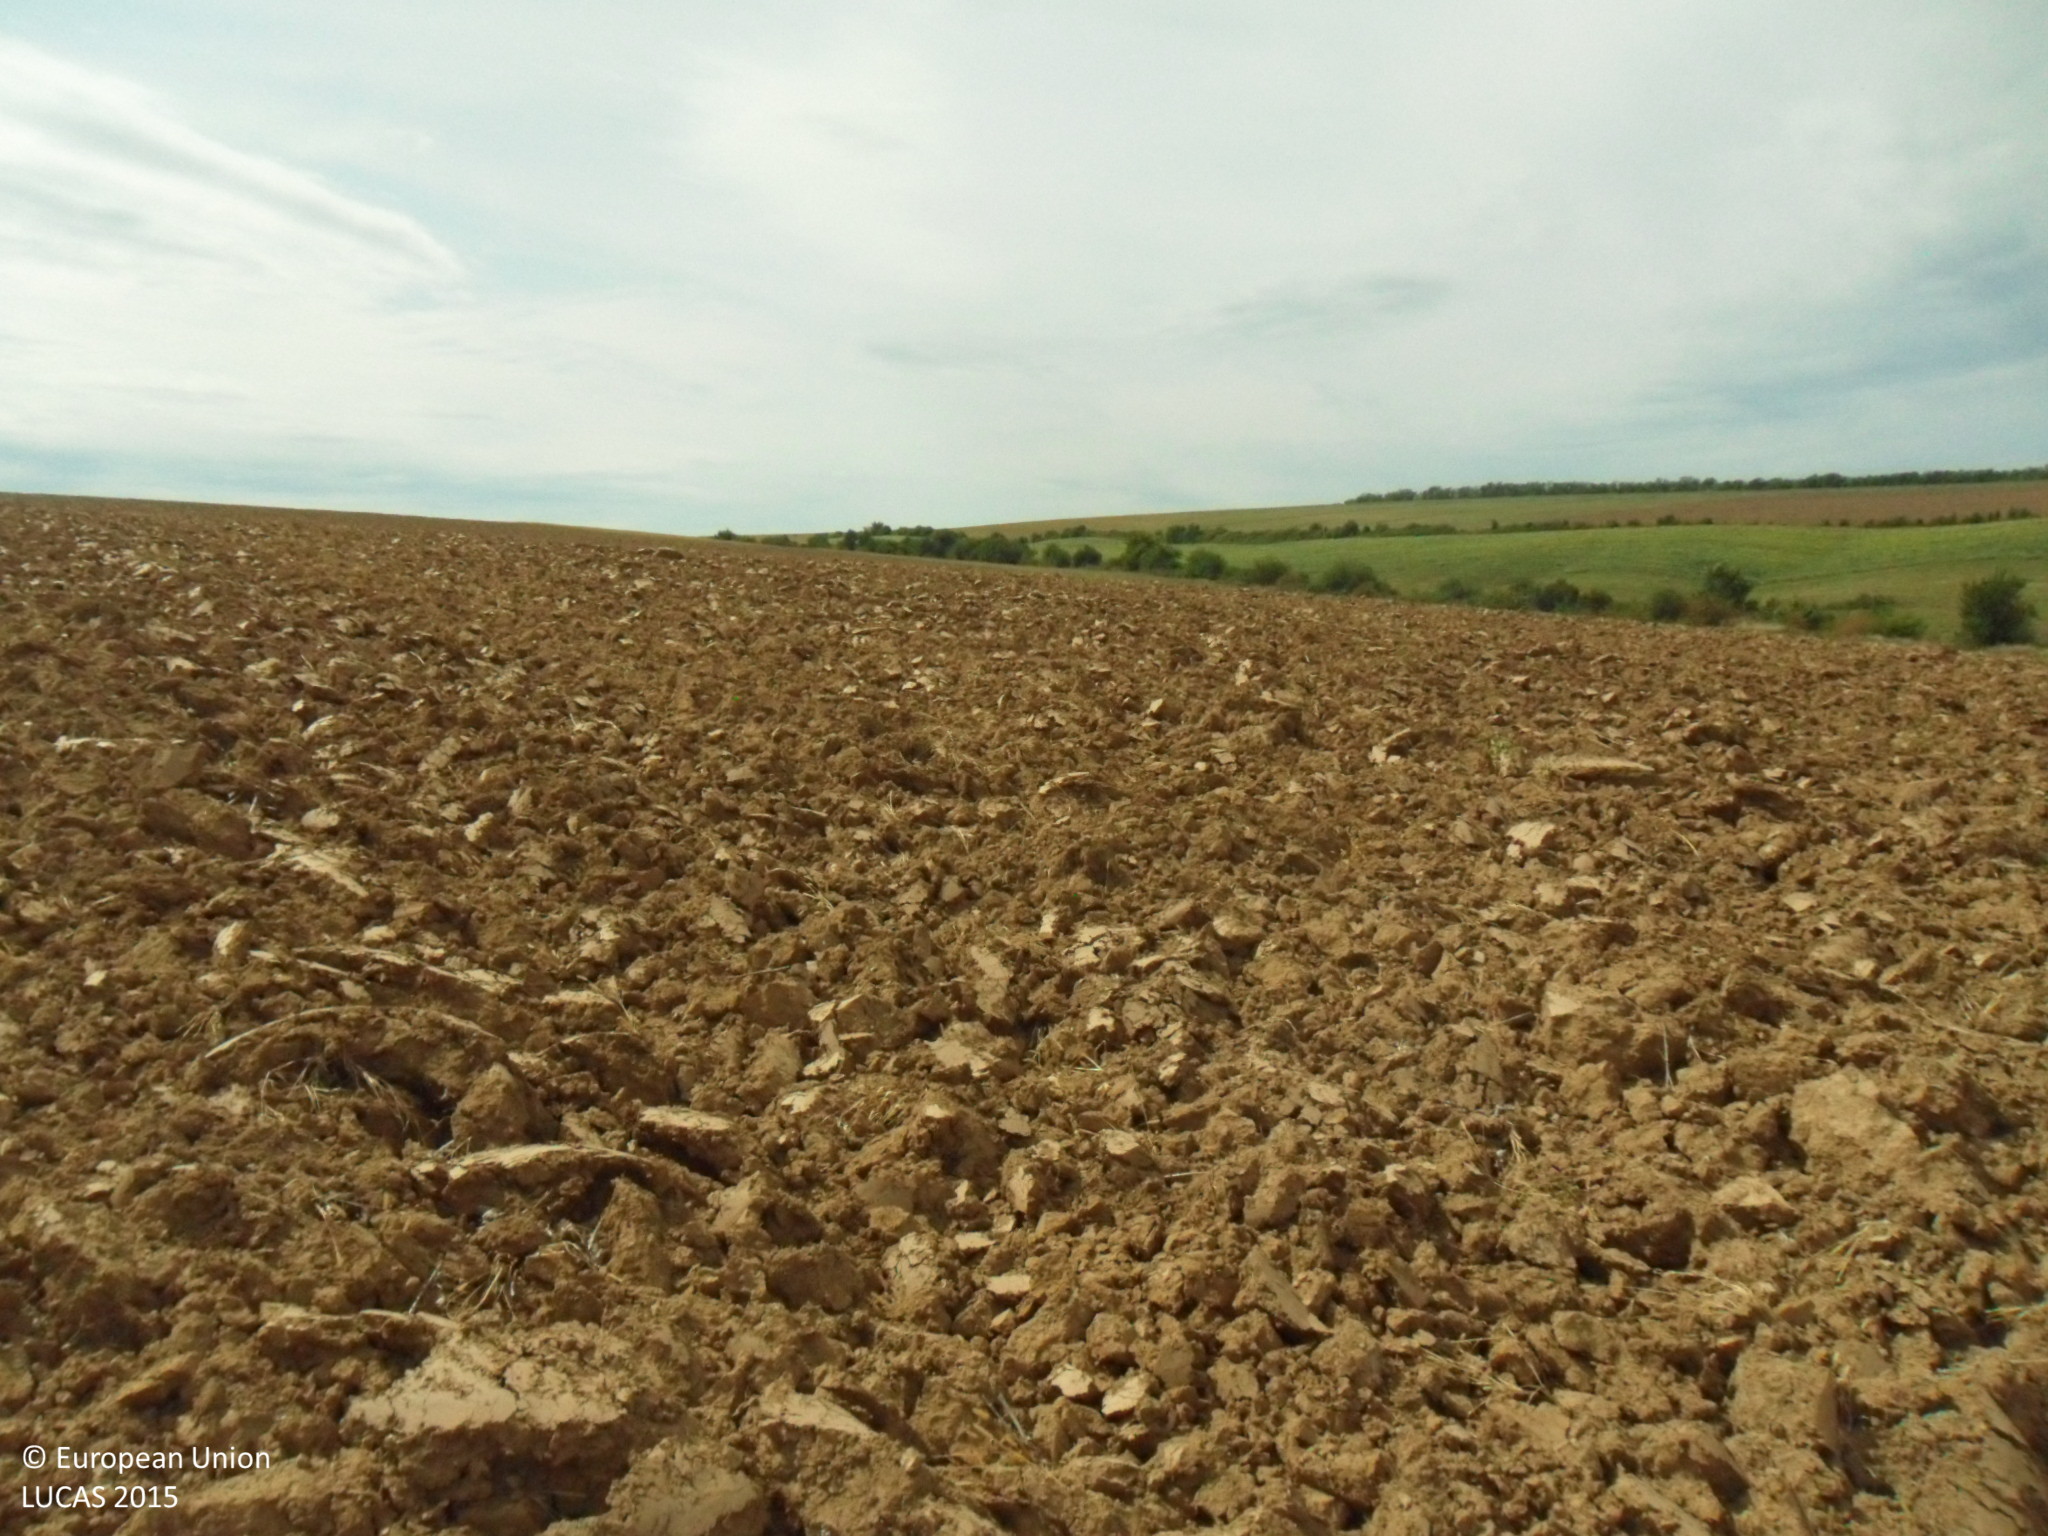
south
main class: Cropland
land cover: Common wheat
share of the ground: < 10 %
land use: Agriculture (excluding fallow land and kitchen gardens)
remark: Harvested field
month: September
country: BG
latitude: 43.5470
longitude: 26.3019
